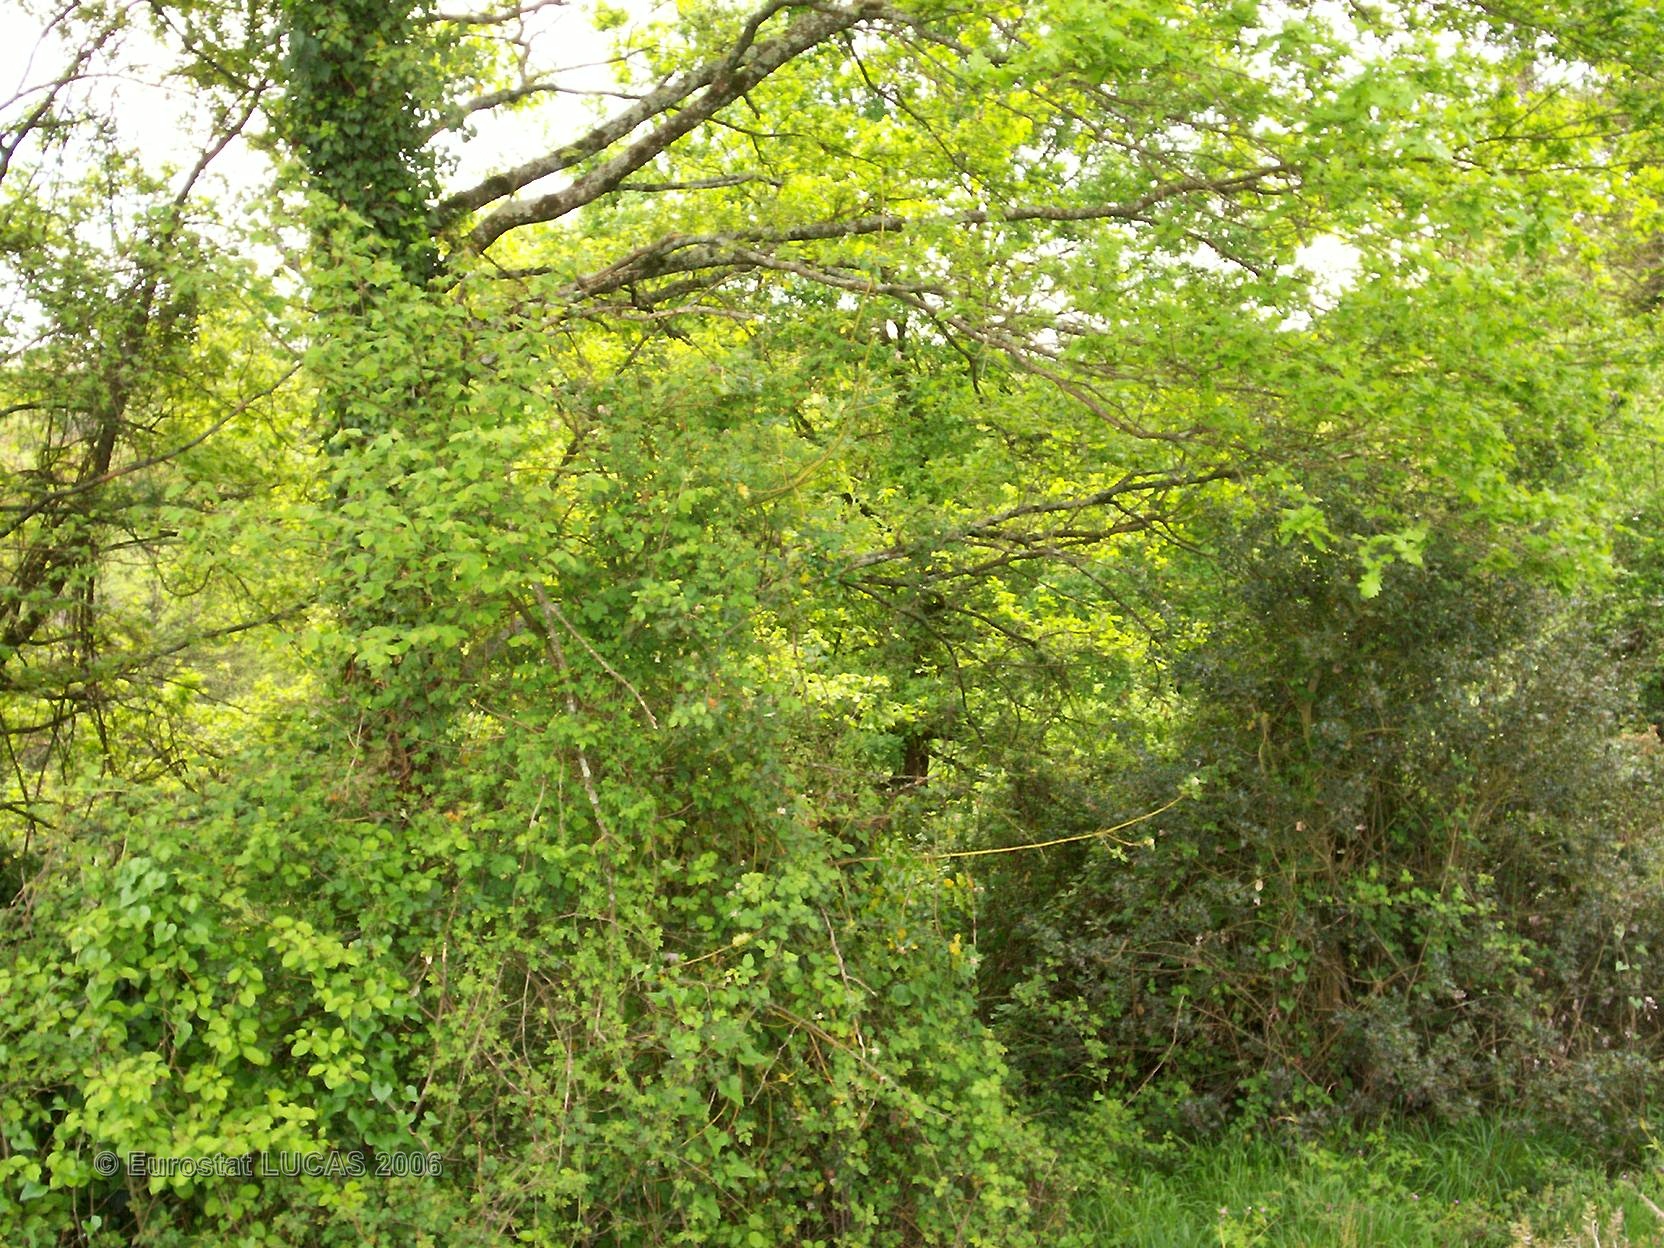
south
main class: Grassland
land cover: Grassland without tree/shrub cover
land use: Agriculture (excluding fallow land and kitchen gardens)
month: April
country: FR
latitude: 43.4911
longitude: -0.6573
